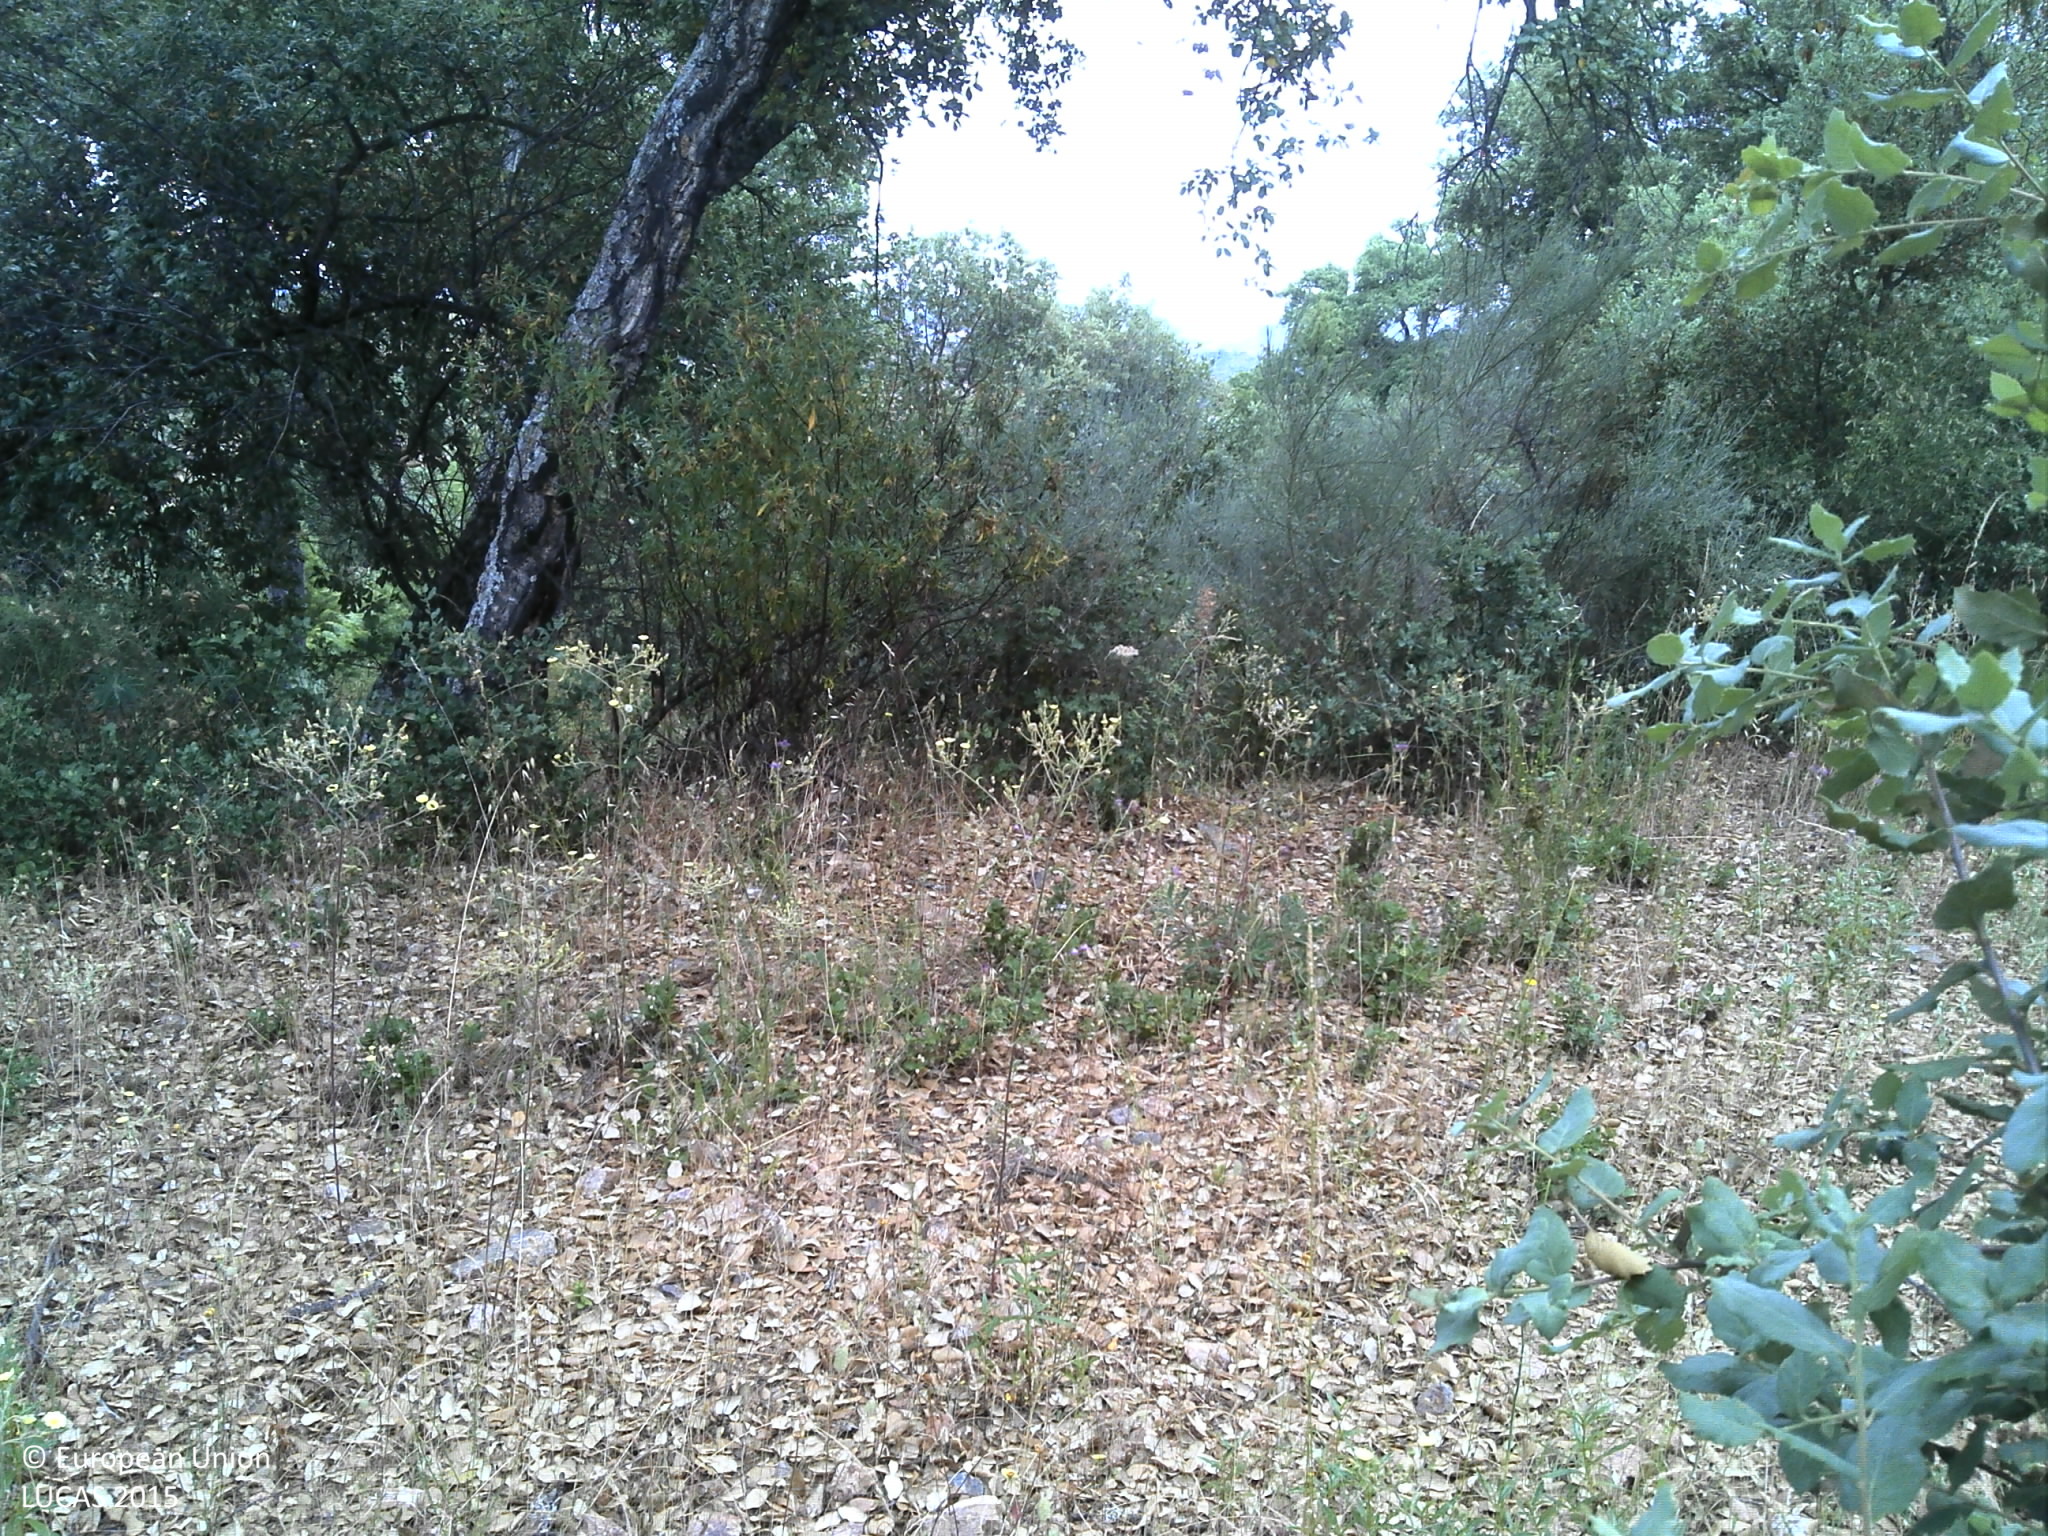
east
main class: Woodland
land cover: Other coniferous woodland
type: coniferous forest of the mediterranean region
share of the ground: < 10 %
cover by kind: shrubs 45 %, herbaceous plants 45 %, coniferous forest trees 10 %
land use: Forestry
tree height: > 5 m
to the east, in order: Other coniferous woodland; Shrubland without tree cover; Other coniferous woodland; Grass margins; Lines of trees; Grass margins; Other coniferous woodland; Lines of trees; Other coniferous woodland; Abandoned hedges; Fences; Grassland without tree/shrub cover; Fences; Broadleaved woodland; Nuts trees; Broadleaved woodland; Nuts trees; Dry stone walls; Tracks; Dry stone walls; Shruby margins; Maize
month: June
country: PT
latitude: 41.2990
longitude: -6.9861
